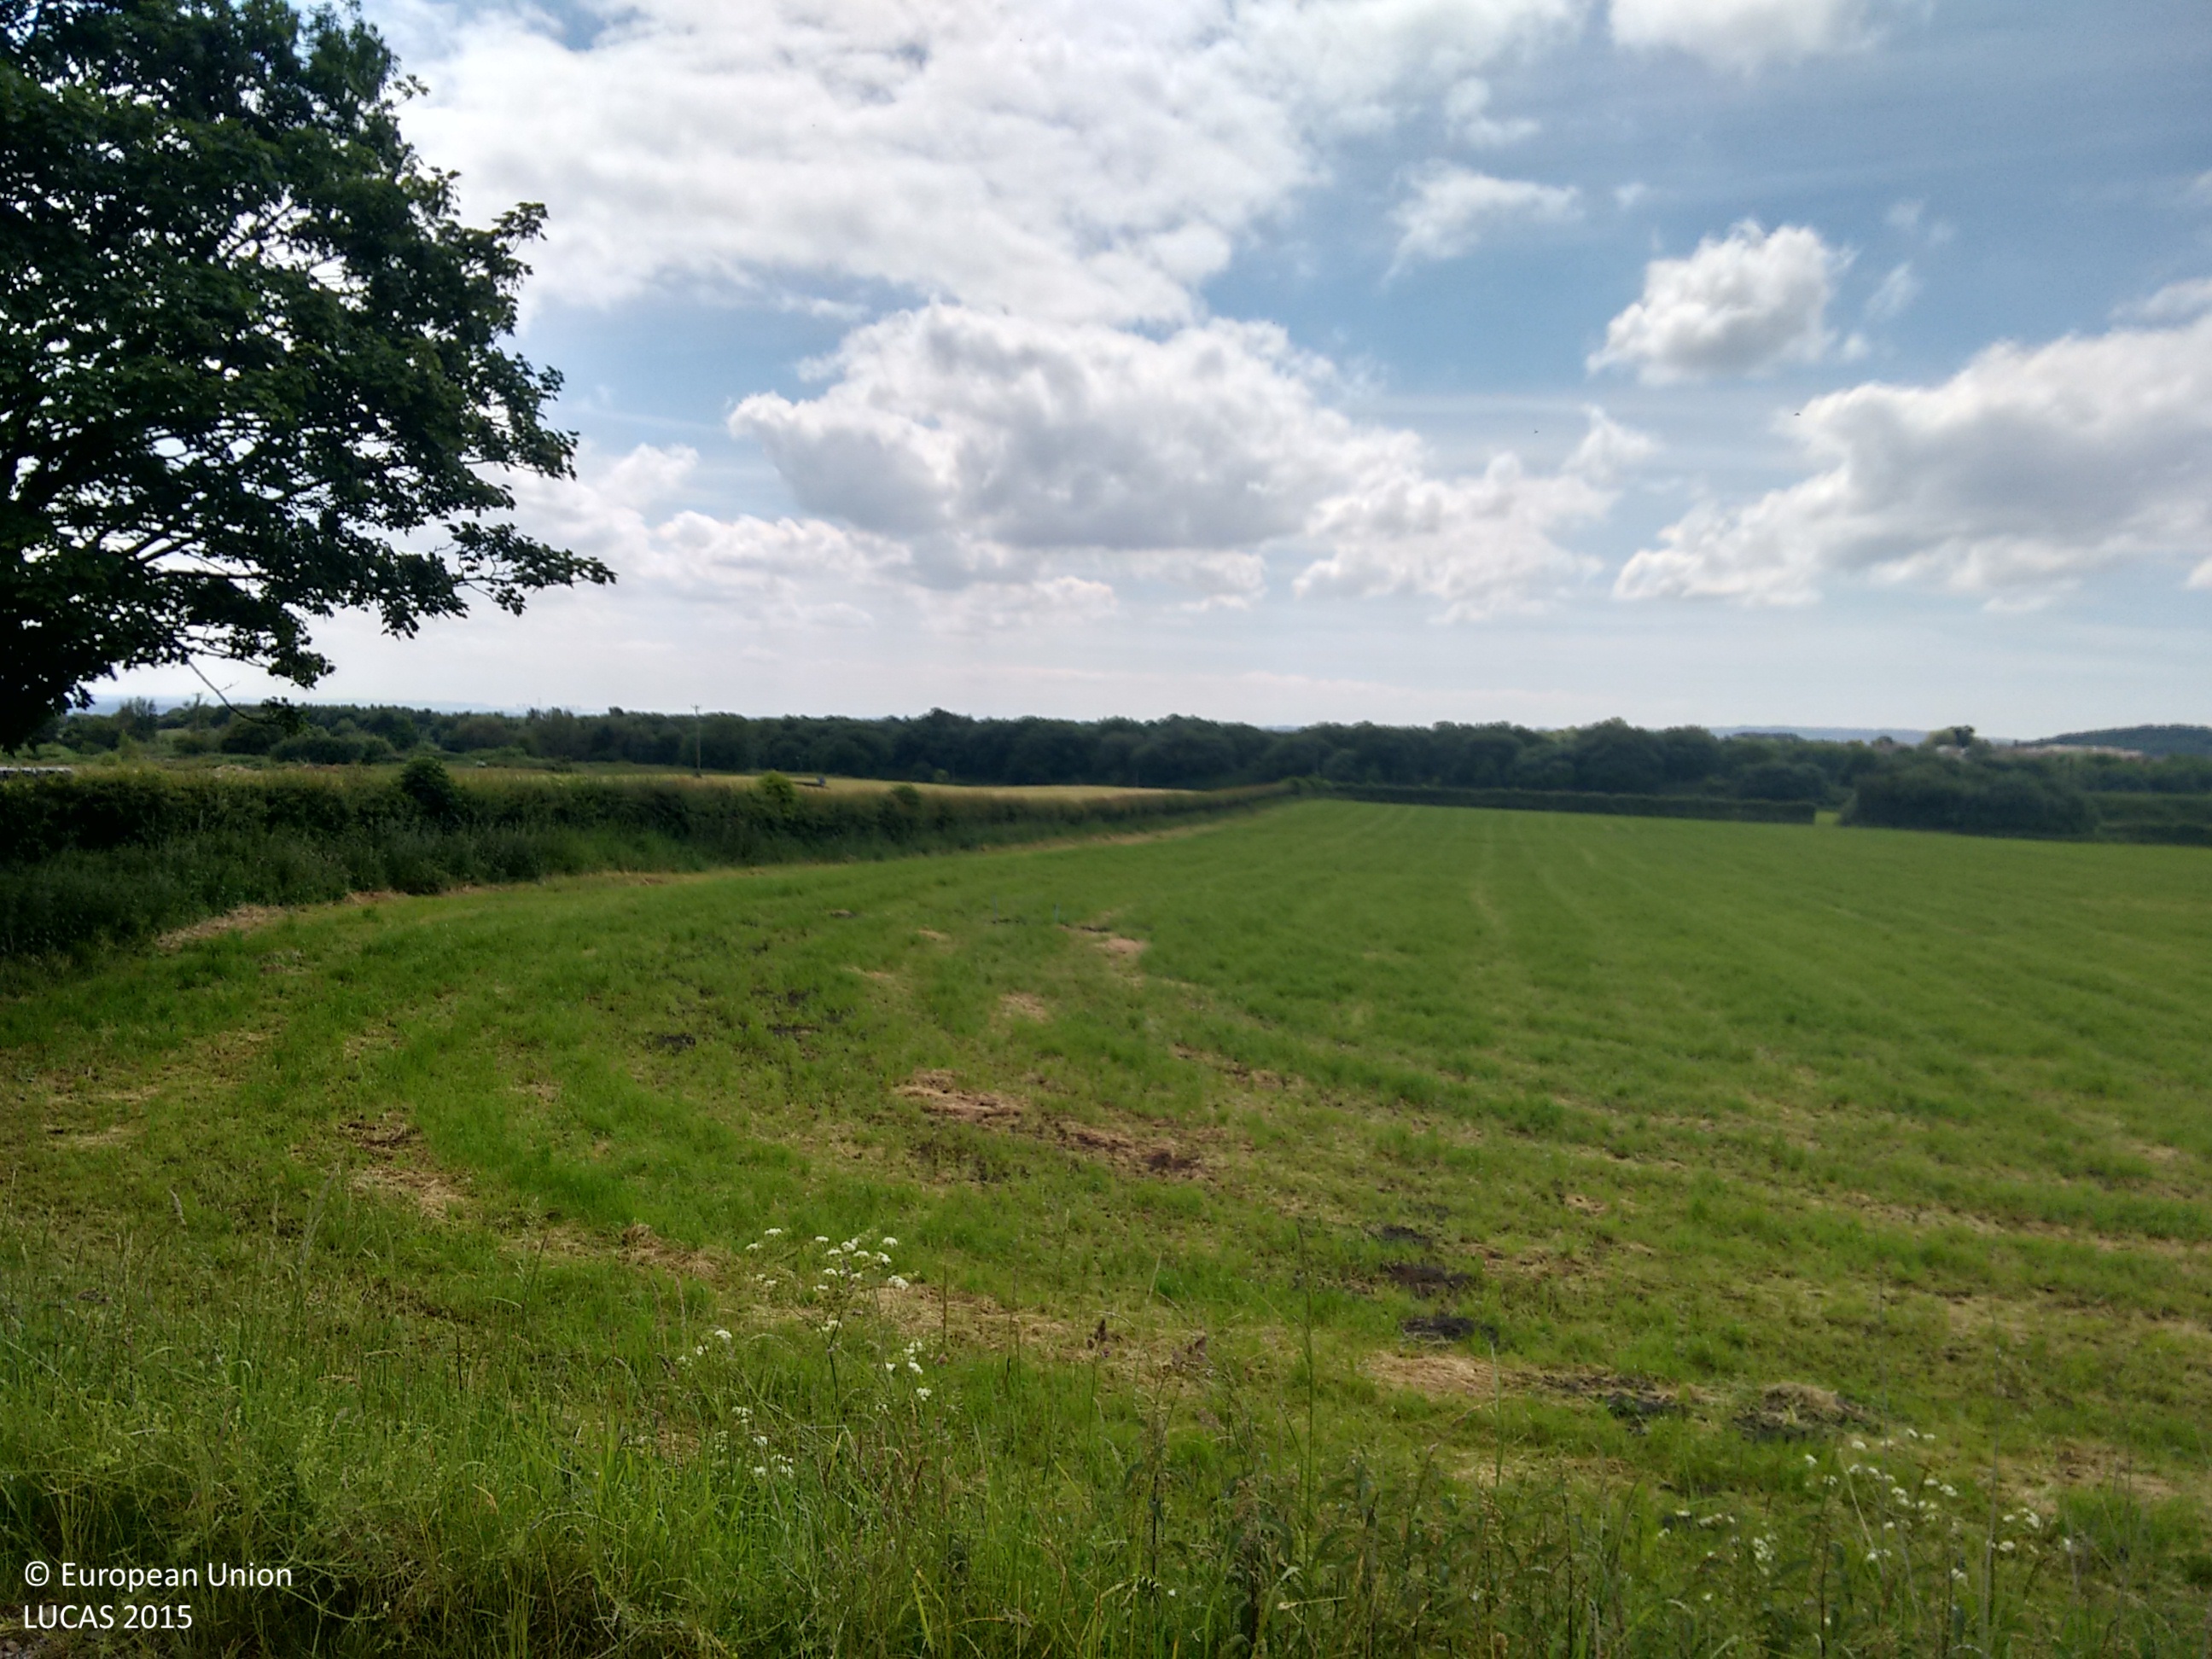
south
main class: Grassland
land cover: Grassland without tree/shrub cover
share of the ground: > 75 %
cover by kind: herbaceous plants 100 %
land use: Agriculture (excluding fallow land and kitchen gardens)
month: June
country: GB
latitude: 53.5648
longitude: -2.5527
